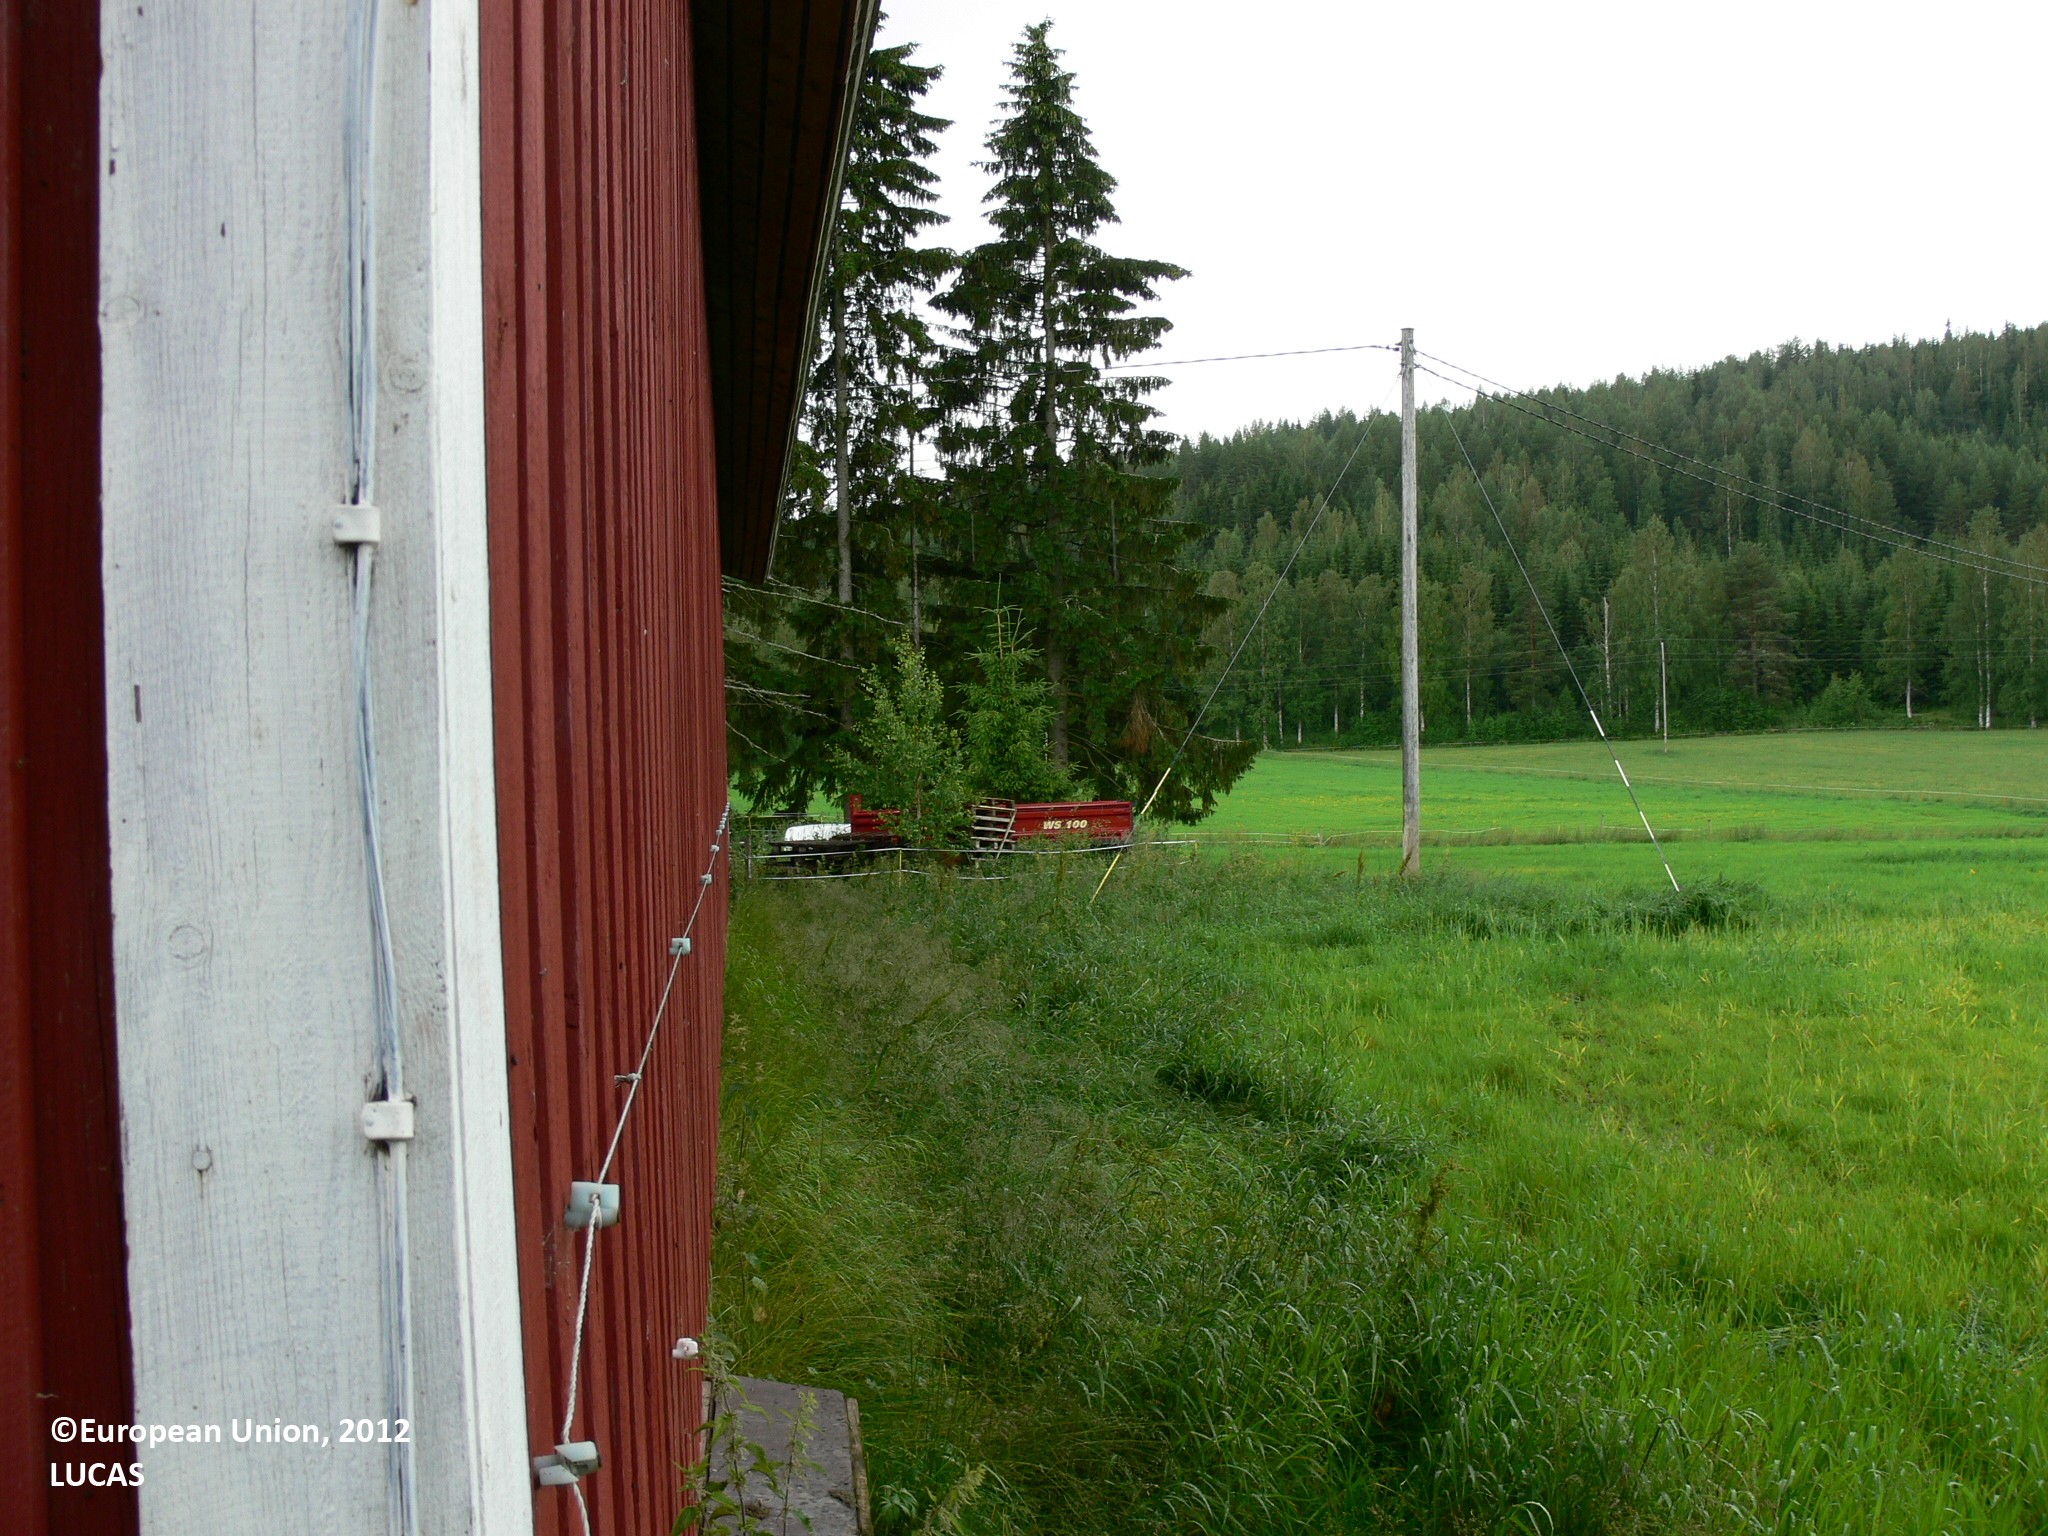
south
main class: Cropland
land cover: Temporary grasslands
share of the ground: > 75 %
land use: Agriculture (excluding fallow land and kitchen gardens)
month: July
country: FI
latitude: 63.2654
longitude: 30.0377
